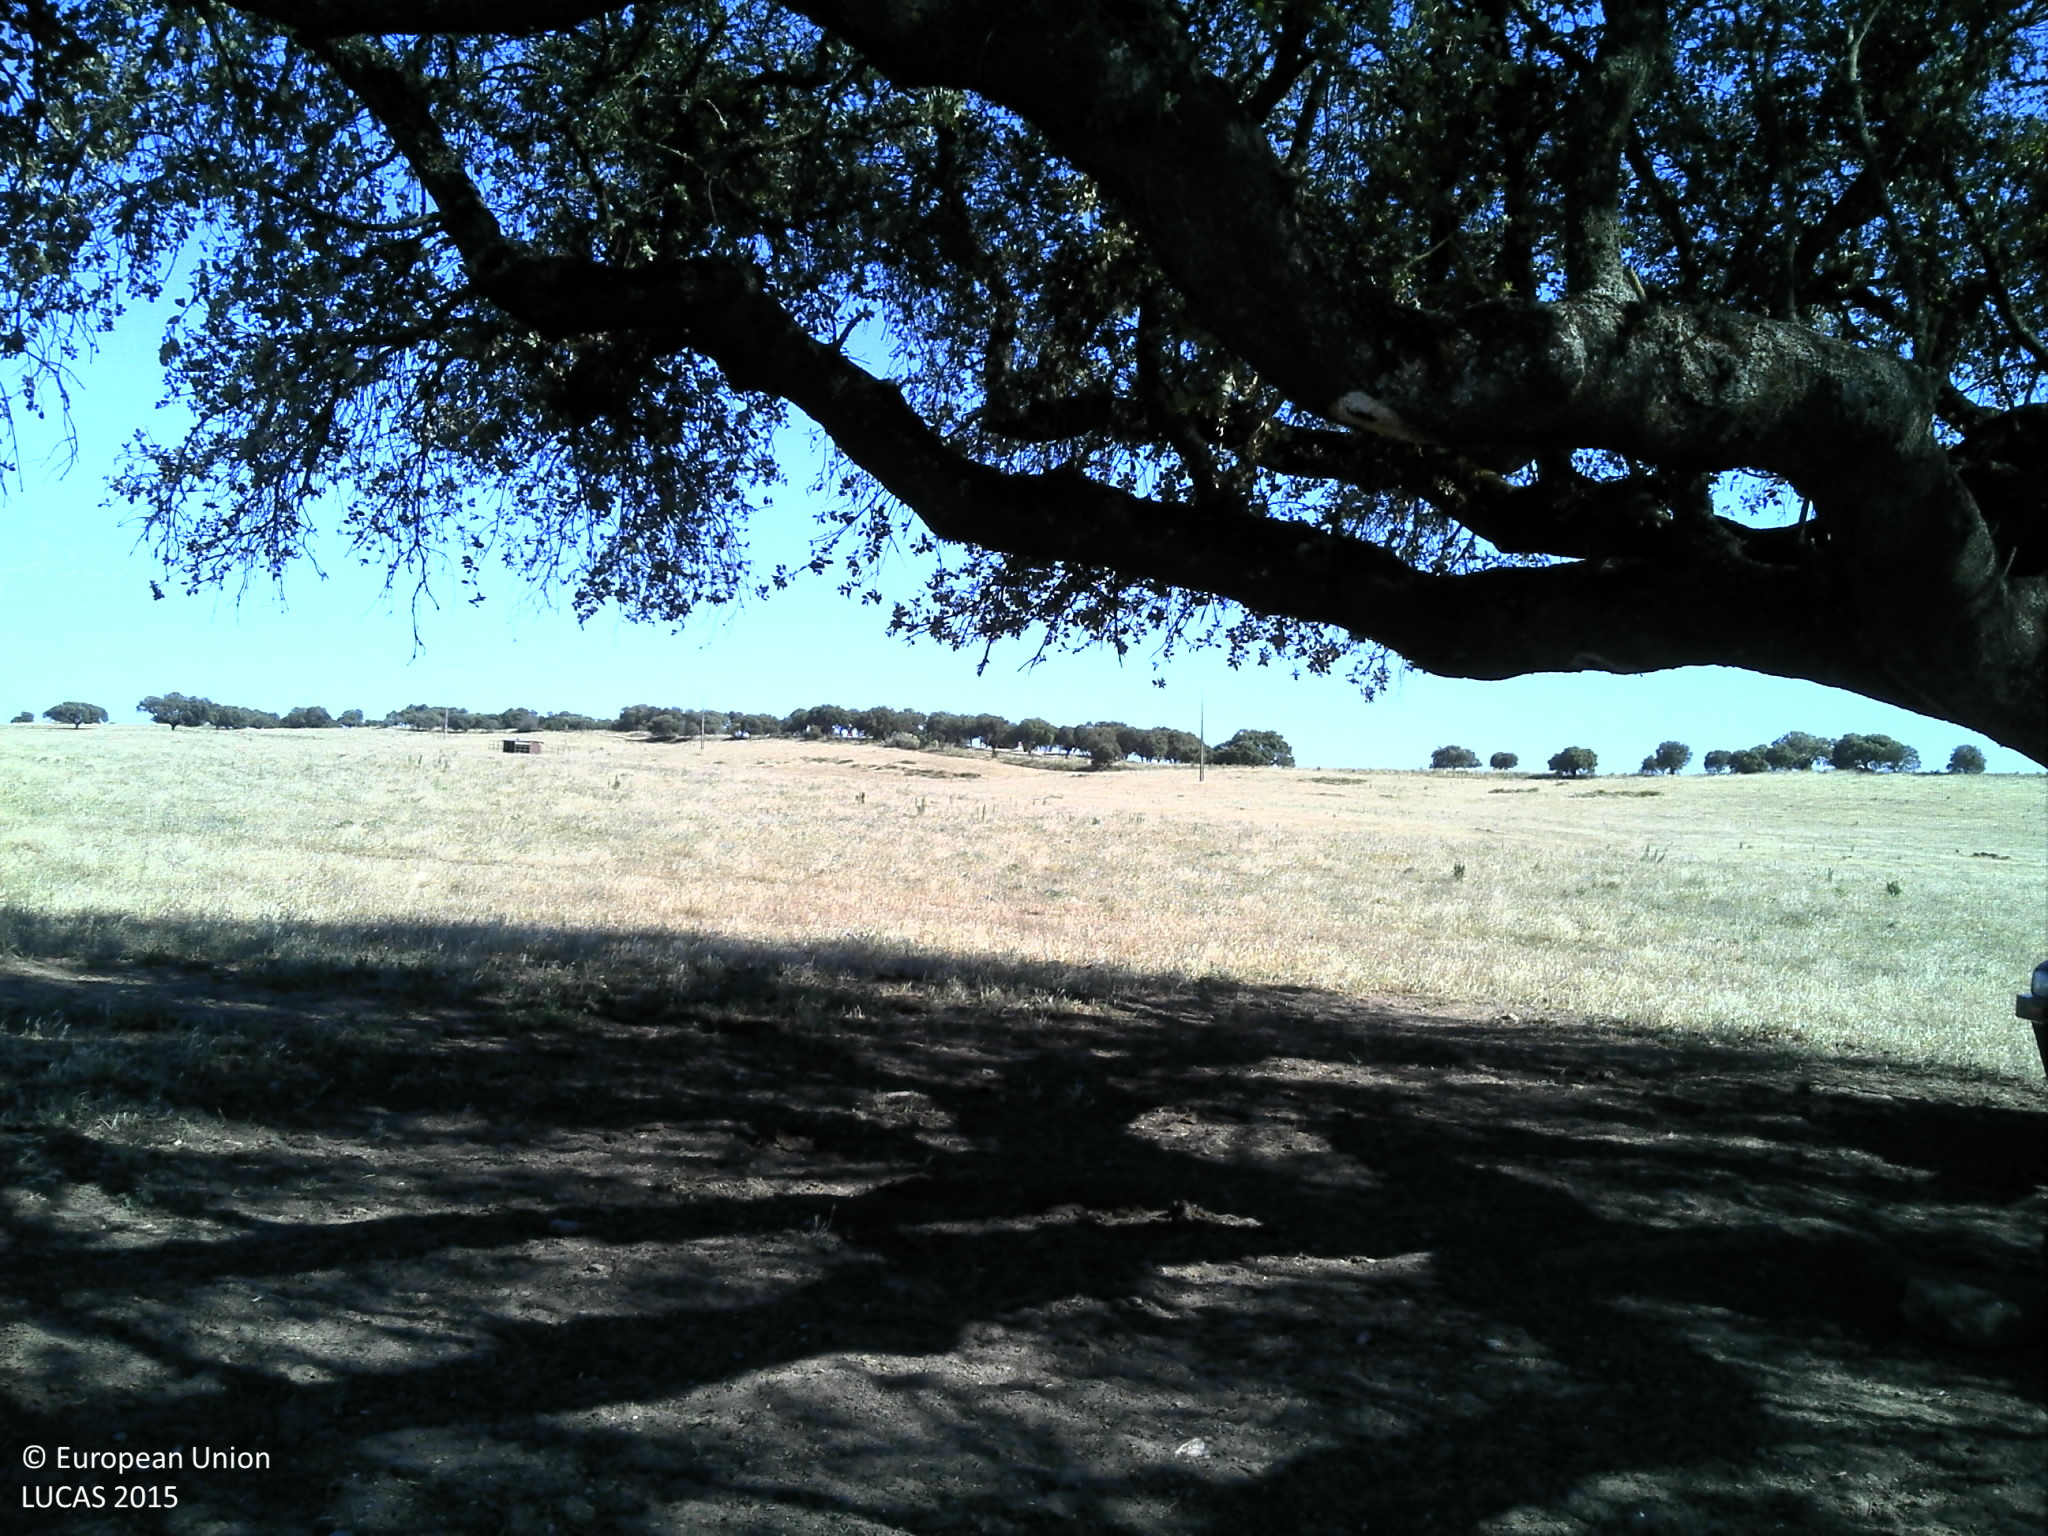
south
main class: Grassland
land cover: Grassland with sparse tree/shrub cover
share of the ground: 50 - 75 %
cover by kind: herbaceous plants 75 %, unconsolidated bare surface 20 %, broadleaved forest trees 5 %
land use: Agriculture (excluding fallow land and kitchen gardens)
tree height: > 5 m
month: May
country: PT
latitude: 39.2529
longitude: -7.6007
